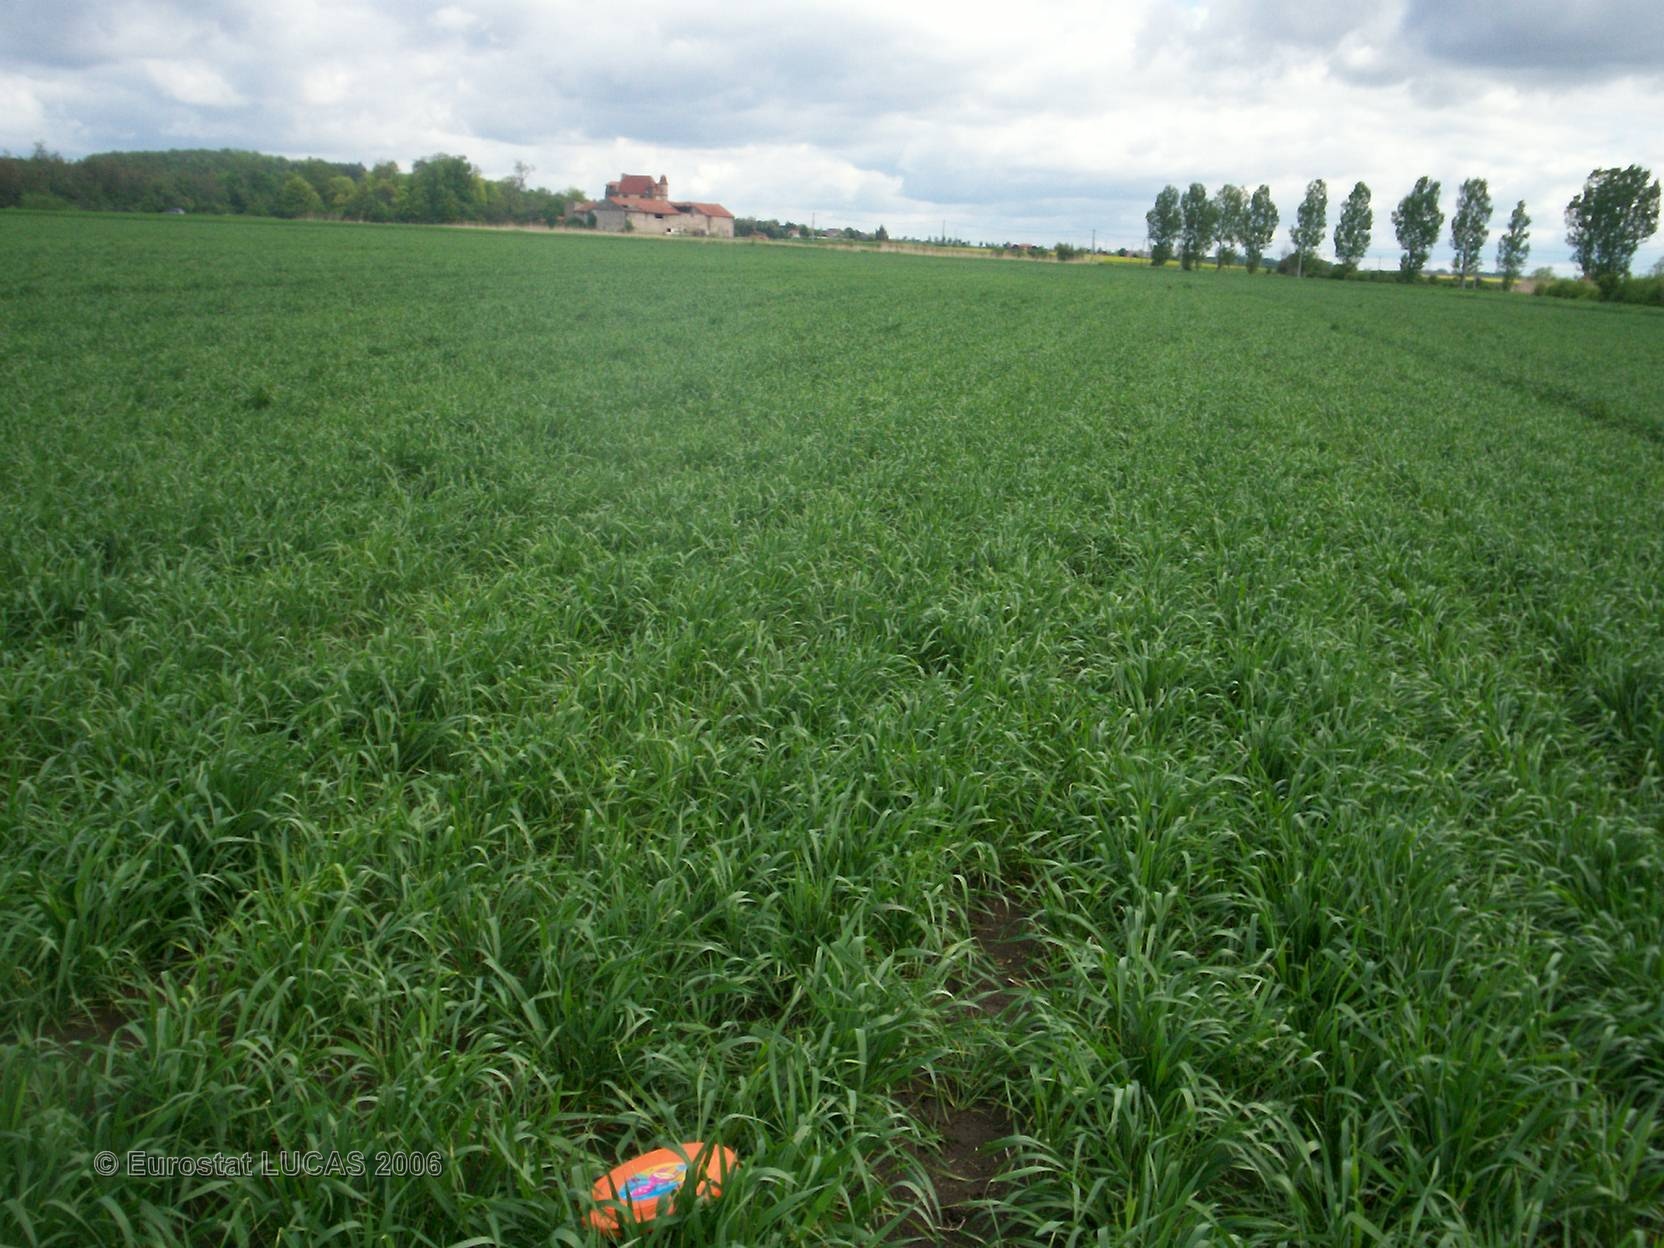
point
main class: Cropland
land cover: Barley
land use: Agriculture (excluding fallow land and kitchen gardens)
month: May
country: FR
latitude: 45.9148
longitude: 3.1535
